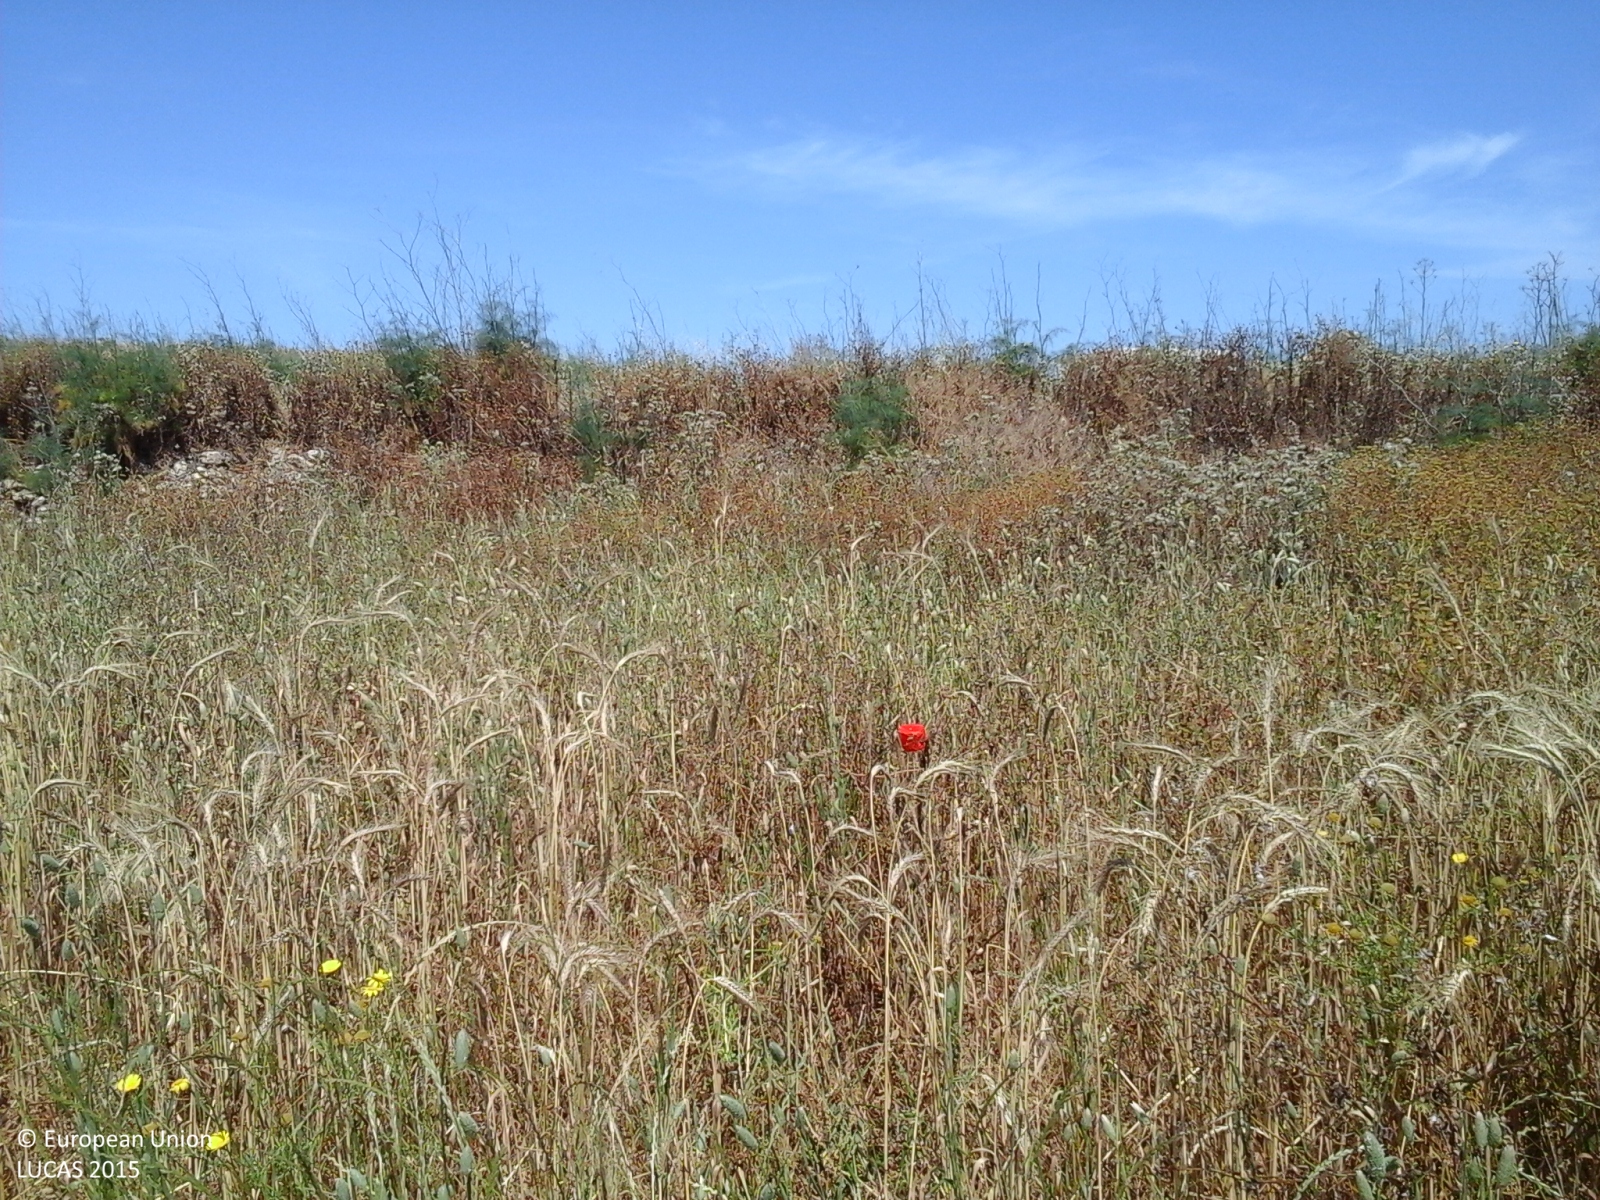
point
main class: Cropland
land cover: Triticale
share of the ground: > 75 %
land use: Agriculture (excluding fallow land and kitchen gardens)
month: May
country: MT
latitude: 36.0693
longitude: 14.2583
